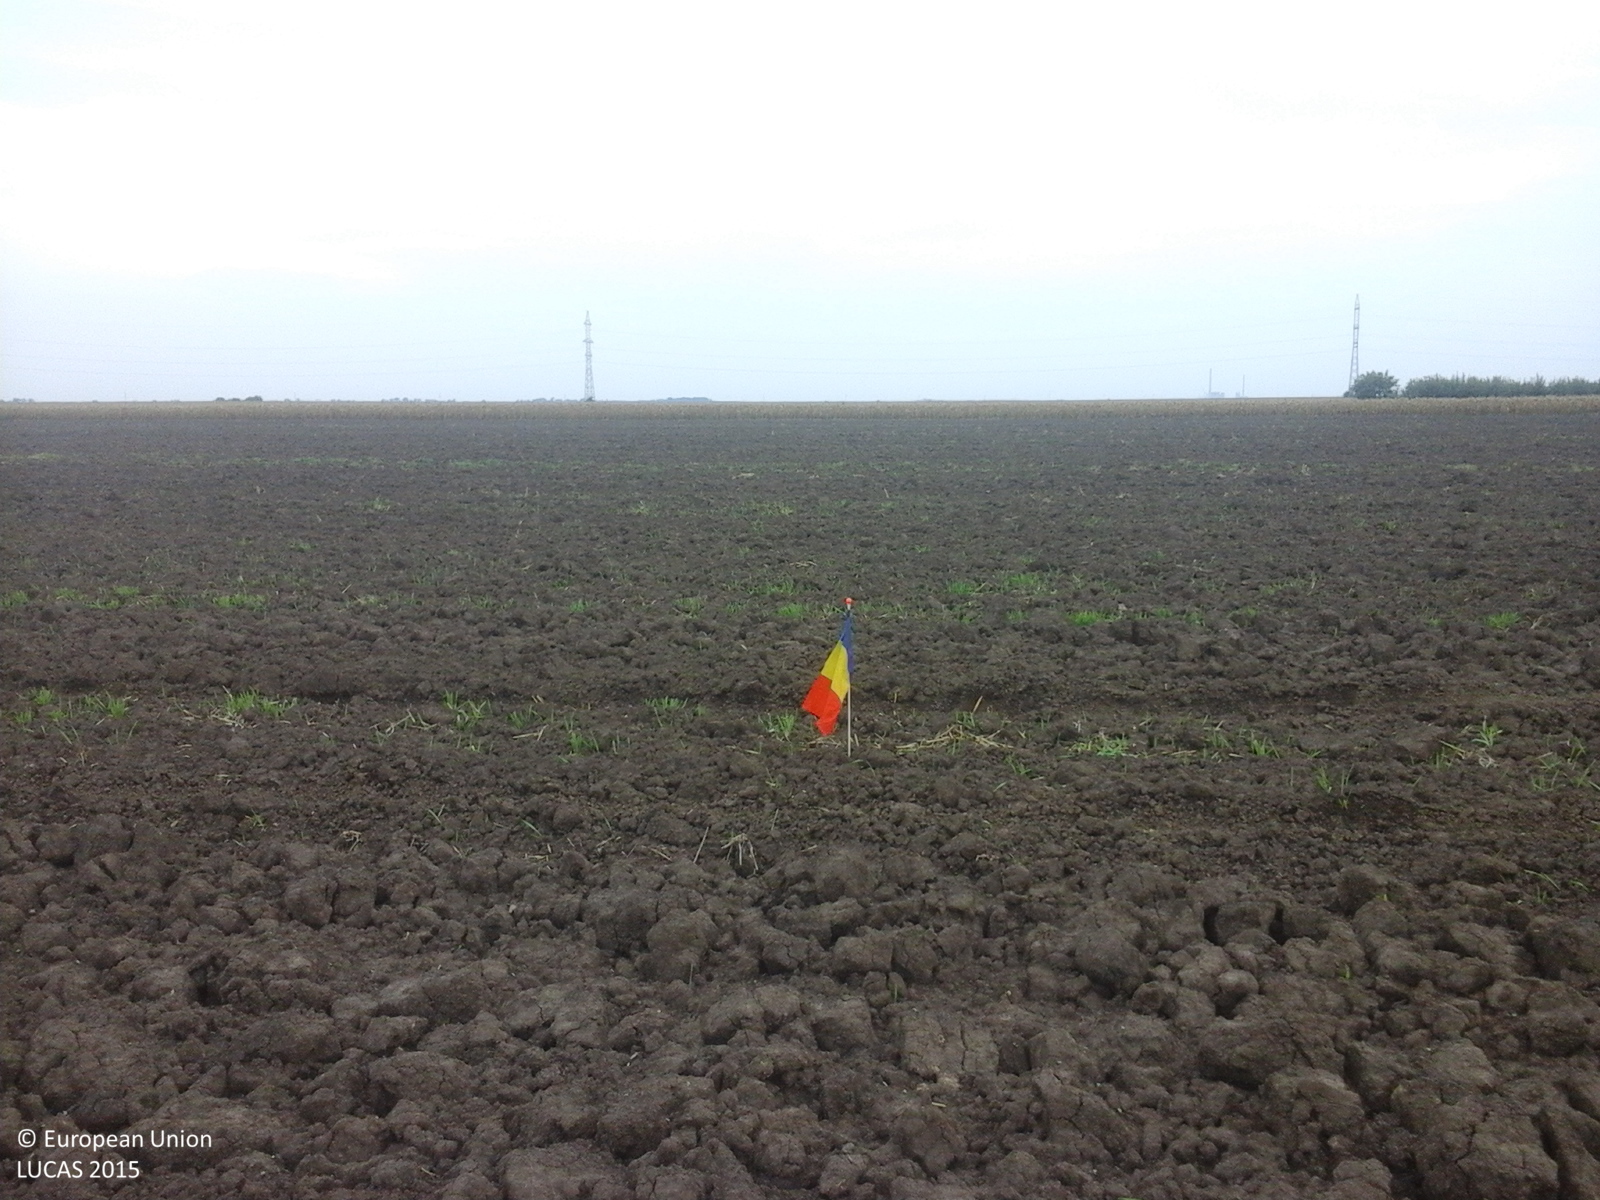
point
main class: Cropland
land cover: Common wheat
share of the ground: < 10 %
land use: Agriculture (excluding fallow land and kitchen gardens)
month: August
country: RO
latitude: 46.3119
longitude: 21.3191
